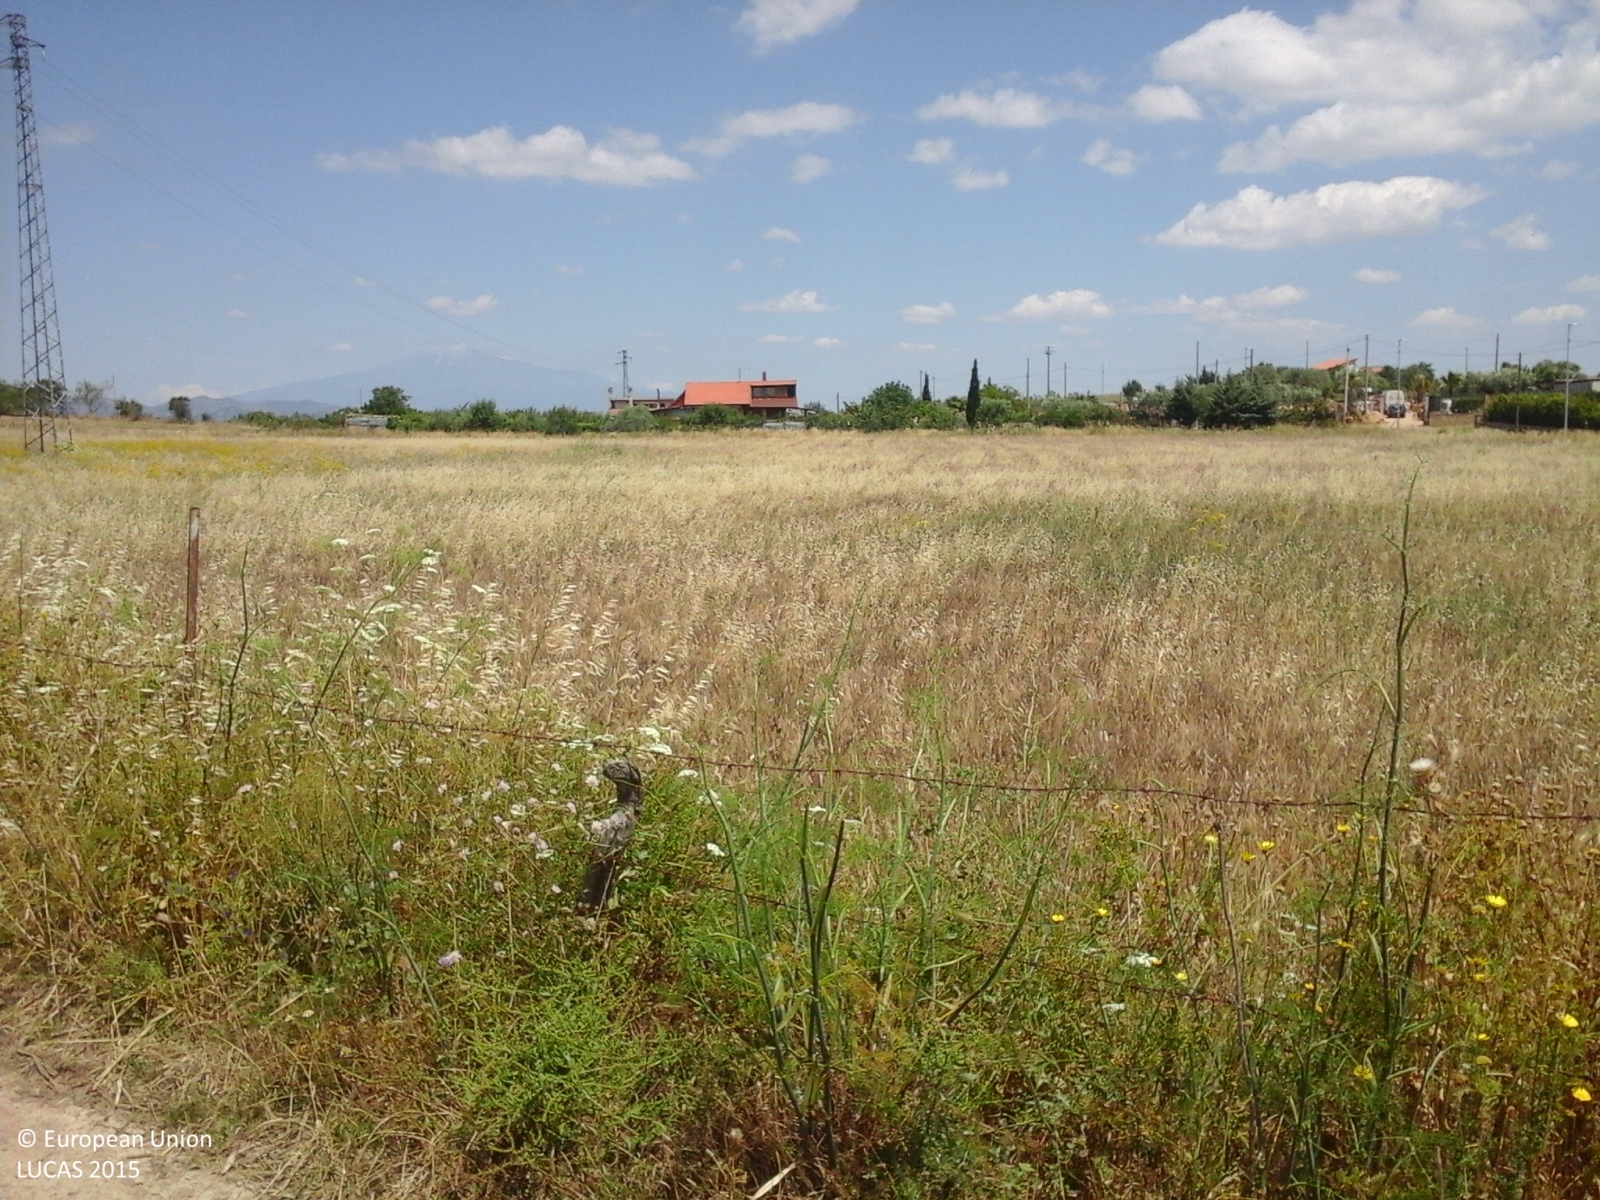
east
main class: Grassland
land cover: Spontaneously vegetated surfaces
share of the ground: > 75 %
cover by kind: herbaceous plants 90 %, unconsolidated bare surface 10 %
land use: Fallow land
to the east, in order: Spontaneously vegetated surfaces; Fences; Tracks; Grass margins; Fences; Grass margins; Durum wheat; Fences; Other bare soil; Grass margins; Fences; Spontaneously vegetated surfaces
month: June
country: IT
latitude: 37.6628
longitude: 14.4233
